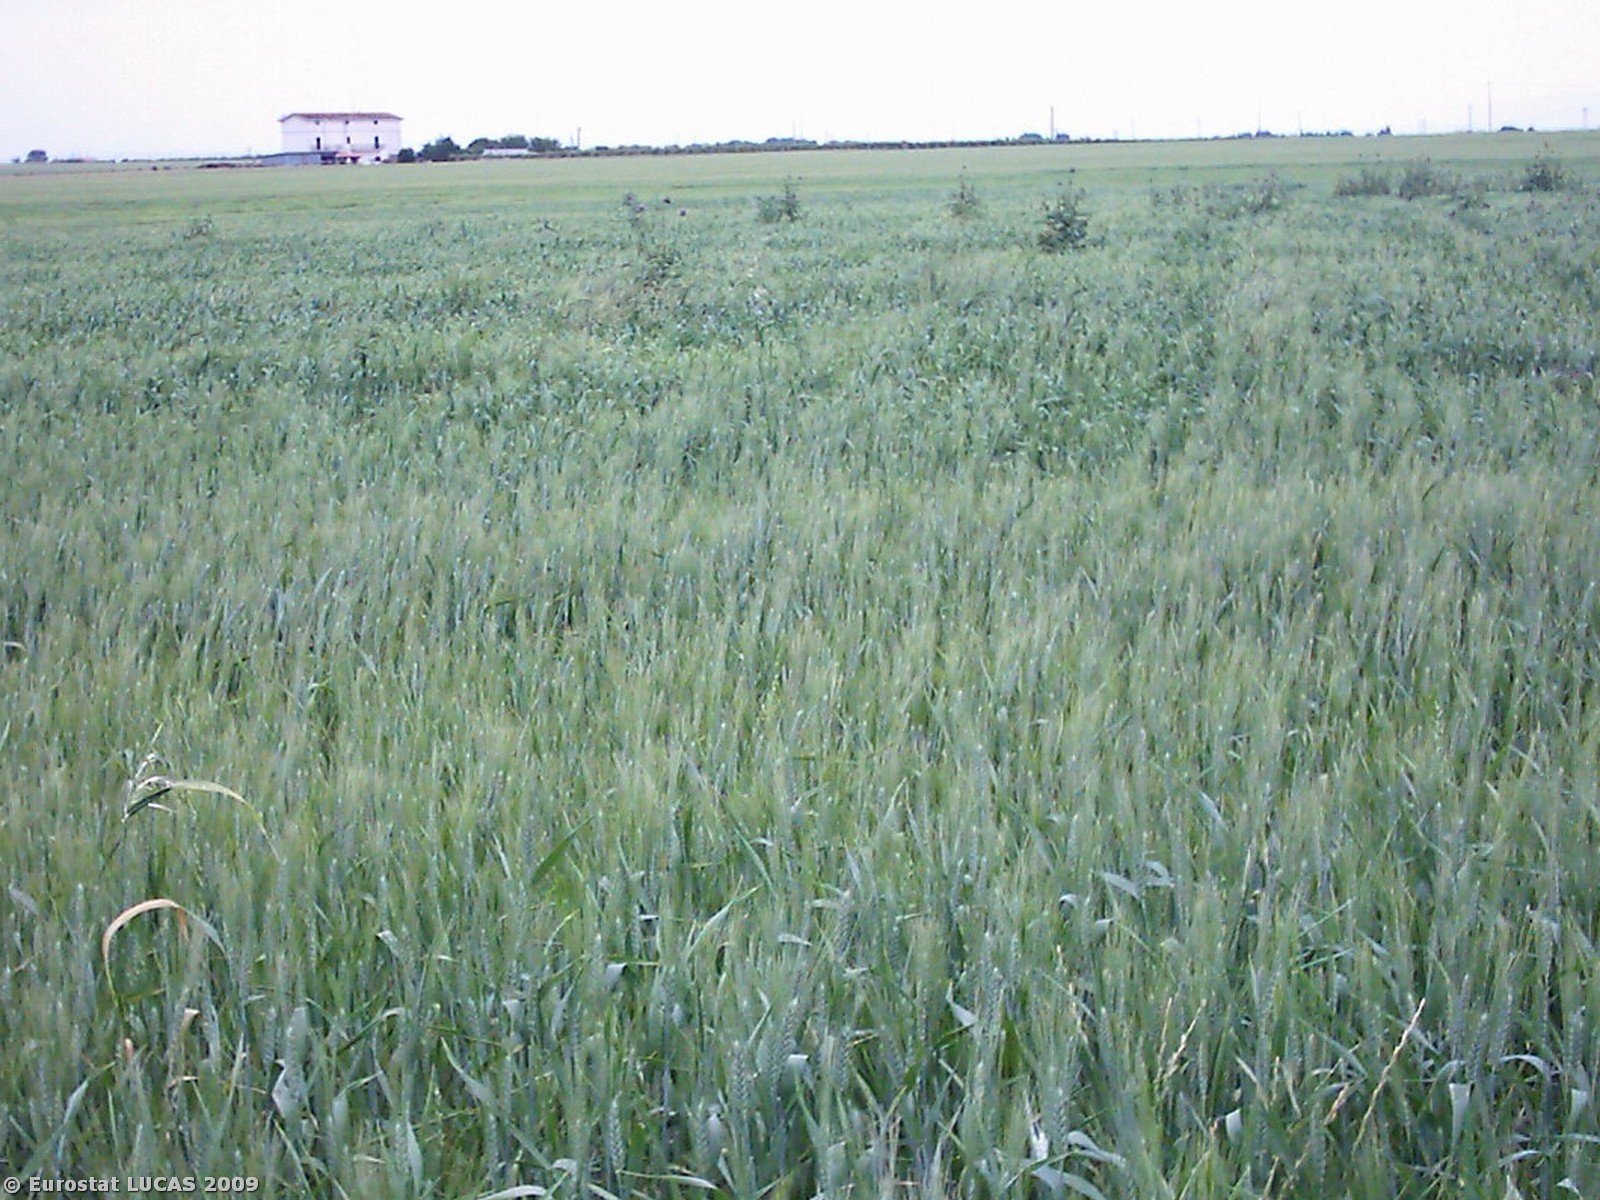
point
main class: Cropland
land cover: Durum wheat
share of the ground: > 75 %
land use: Agriculture (excluding fallow land and kitchen gardens)
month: May
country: IT
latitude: 41.5185
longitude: 15.6499
